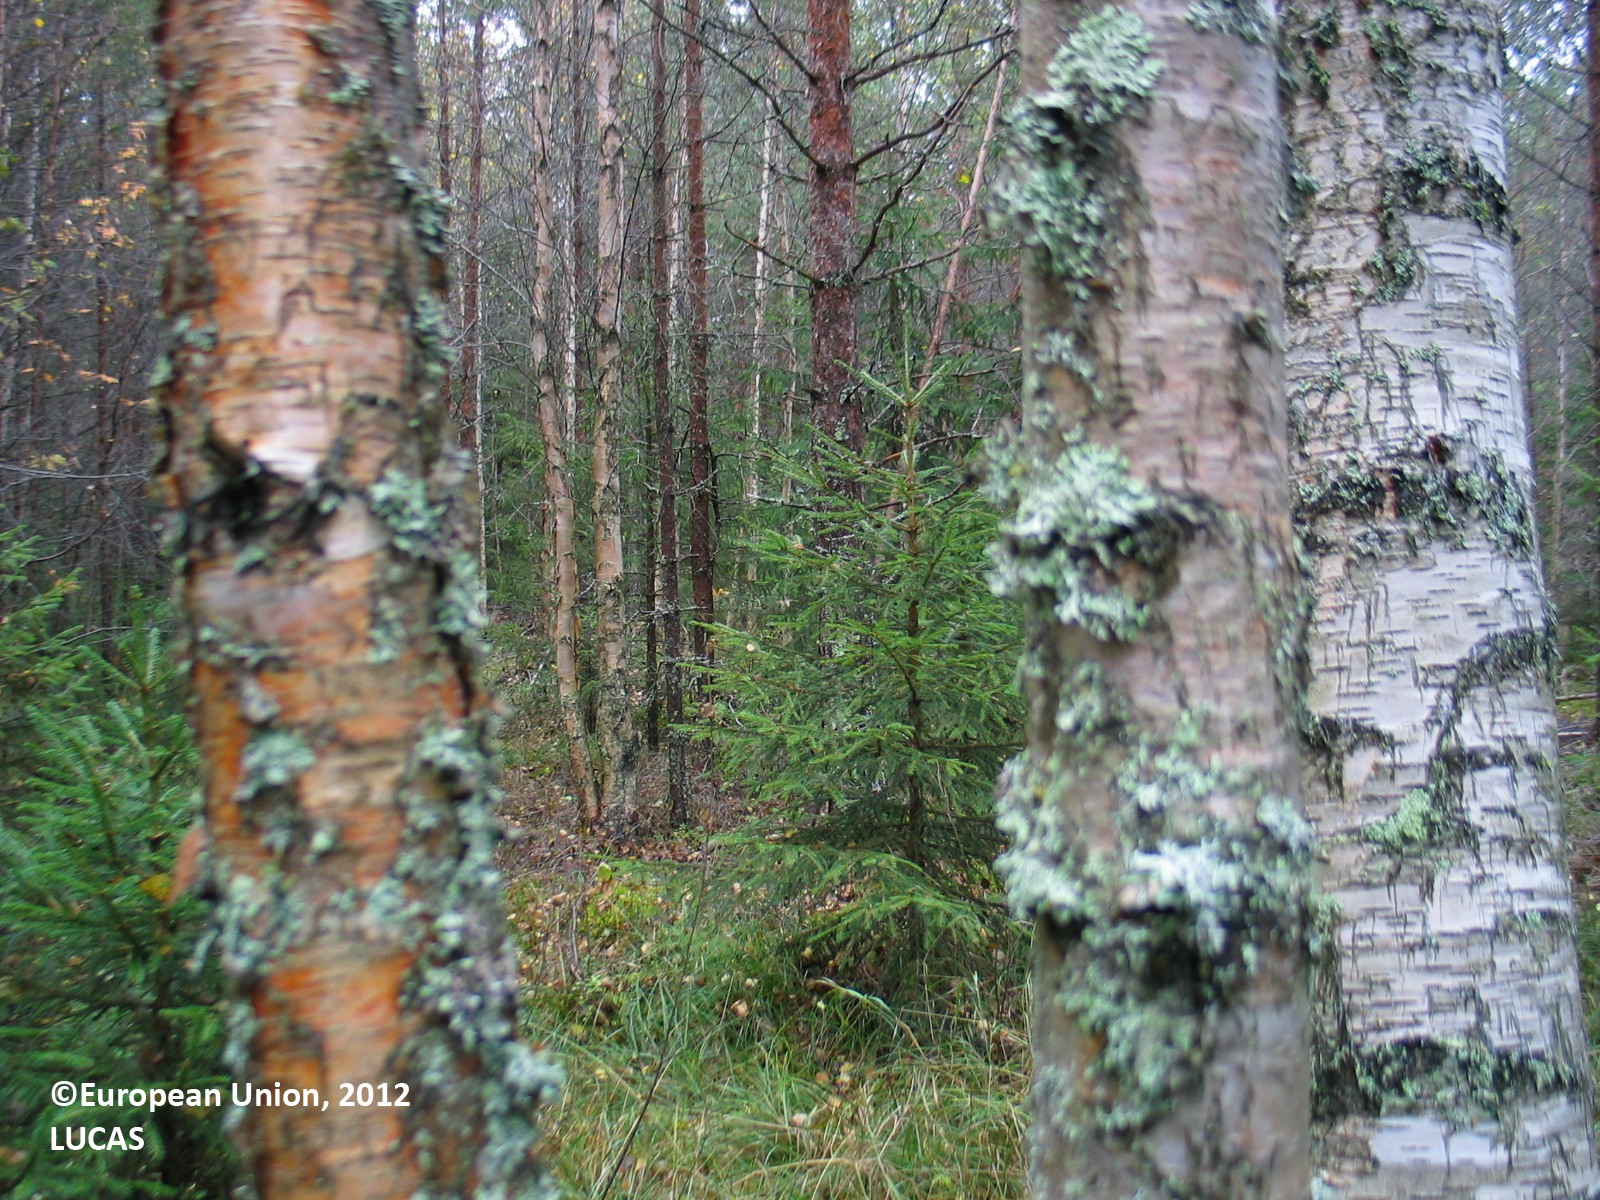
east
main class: Woodland
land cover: Other mixed woodland
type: boreal forest
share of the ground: 50 - 75 %
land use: Forestry
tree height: > 5 m
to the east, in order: Other mixed woodland; Pine dominated coniferous woodland; Ditches and canals; Pine dominated coniferous woodland; Ditches and canals; Shrubland without tree cover; Broadleaved woodland
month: September
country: FI
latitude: 65.3513
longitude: 25.4868
